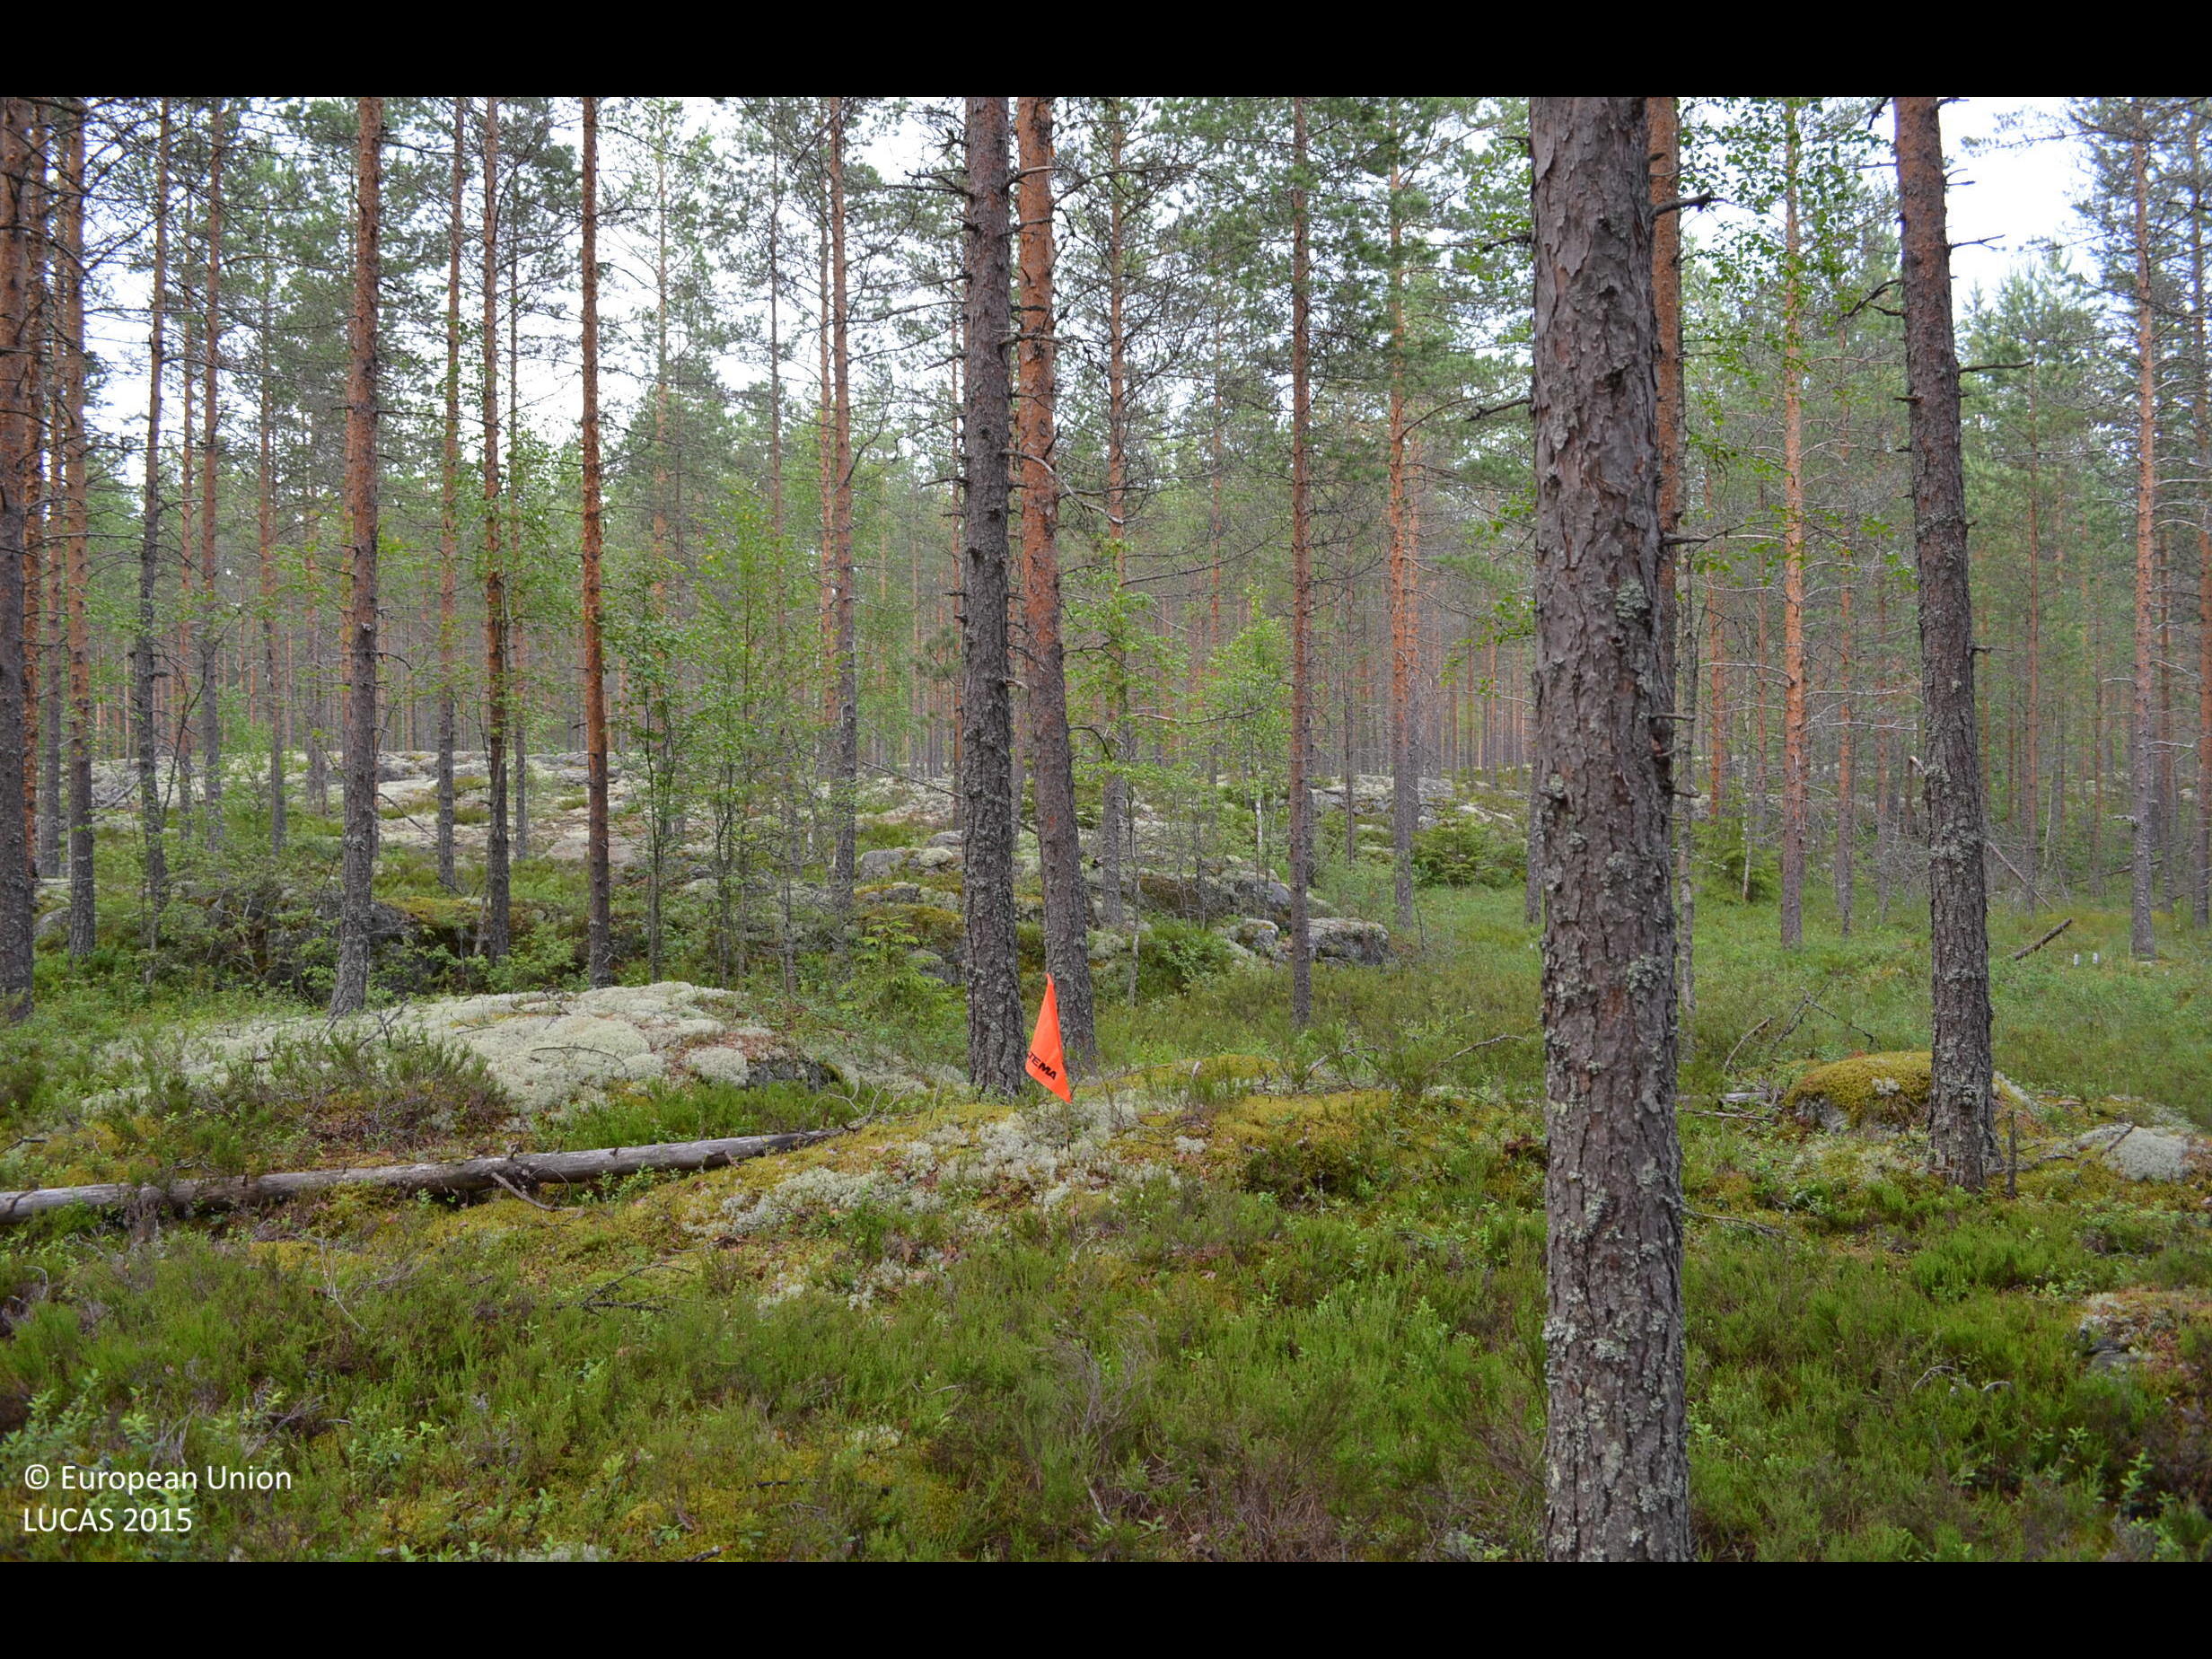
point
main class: Woodland
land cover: Pine dominated coniferous woodland
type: boreal forest
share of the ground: 50 - 75 %
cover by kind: coniferous forest trees 60 %, shrubs 20 %, lichens and mosses 20 %
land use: Forestry
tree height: > 5 m
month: July
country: FI
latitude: 62.2085
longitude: 23.4340
